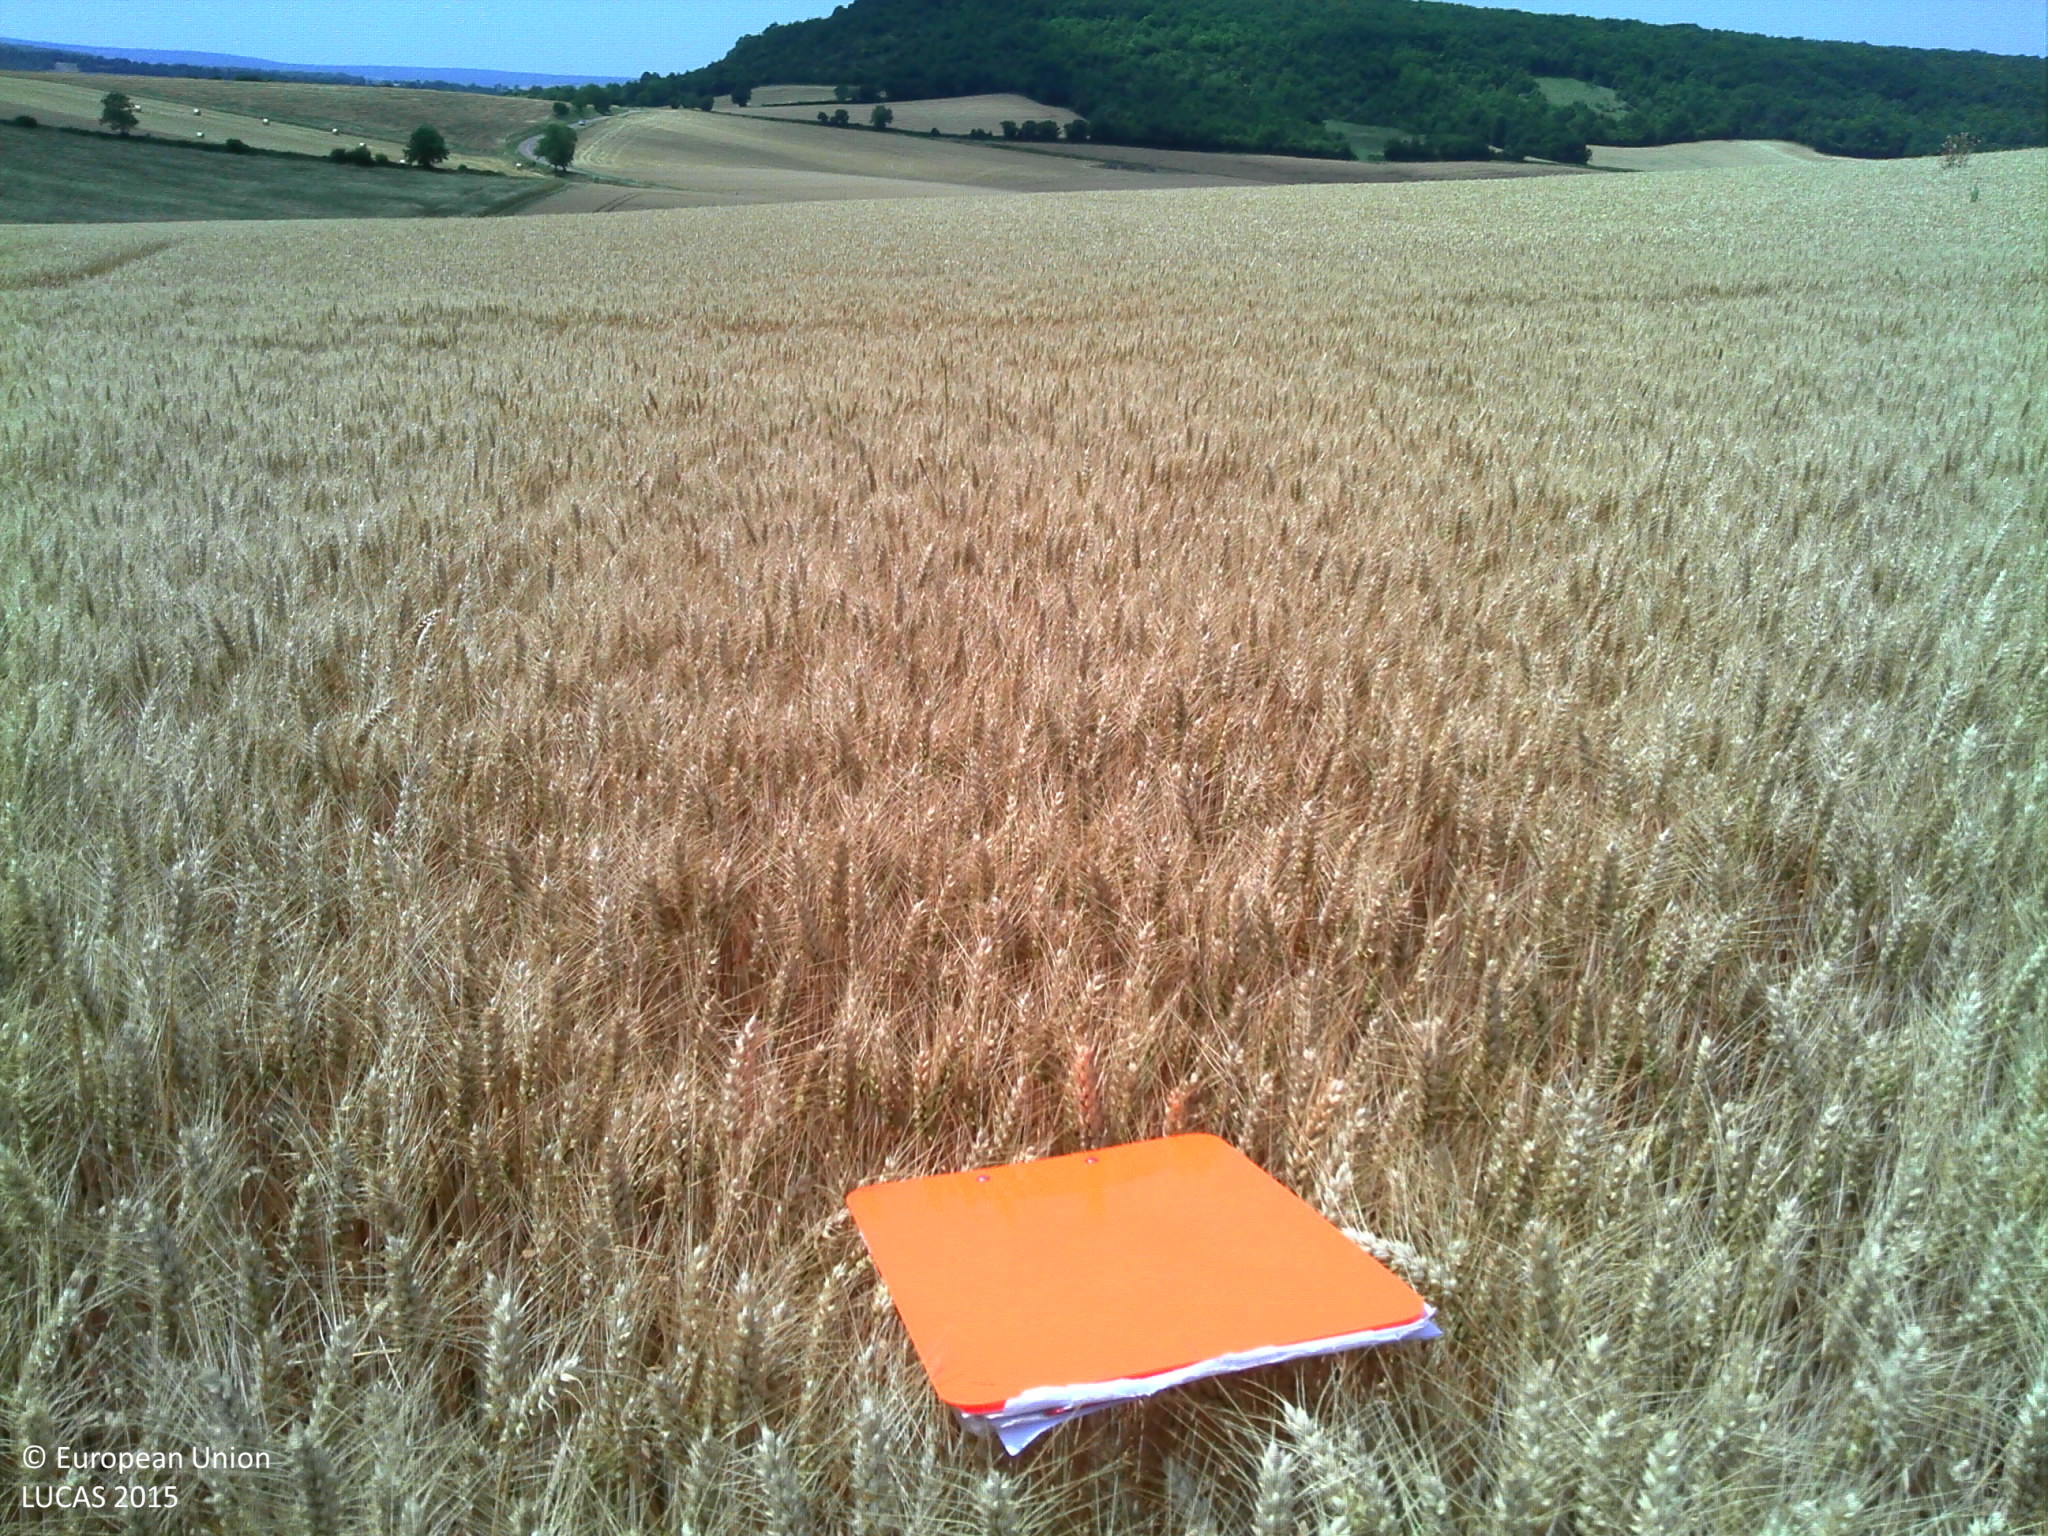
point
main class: Cropland
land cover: Durum wheat
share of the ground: > 75 %
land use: Agriculture (excluding fallow land and kitchen gardens)
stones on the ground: 10 - 25 %
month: July
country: FR
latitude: 47.2932
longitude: 3.5305
